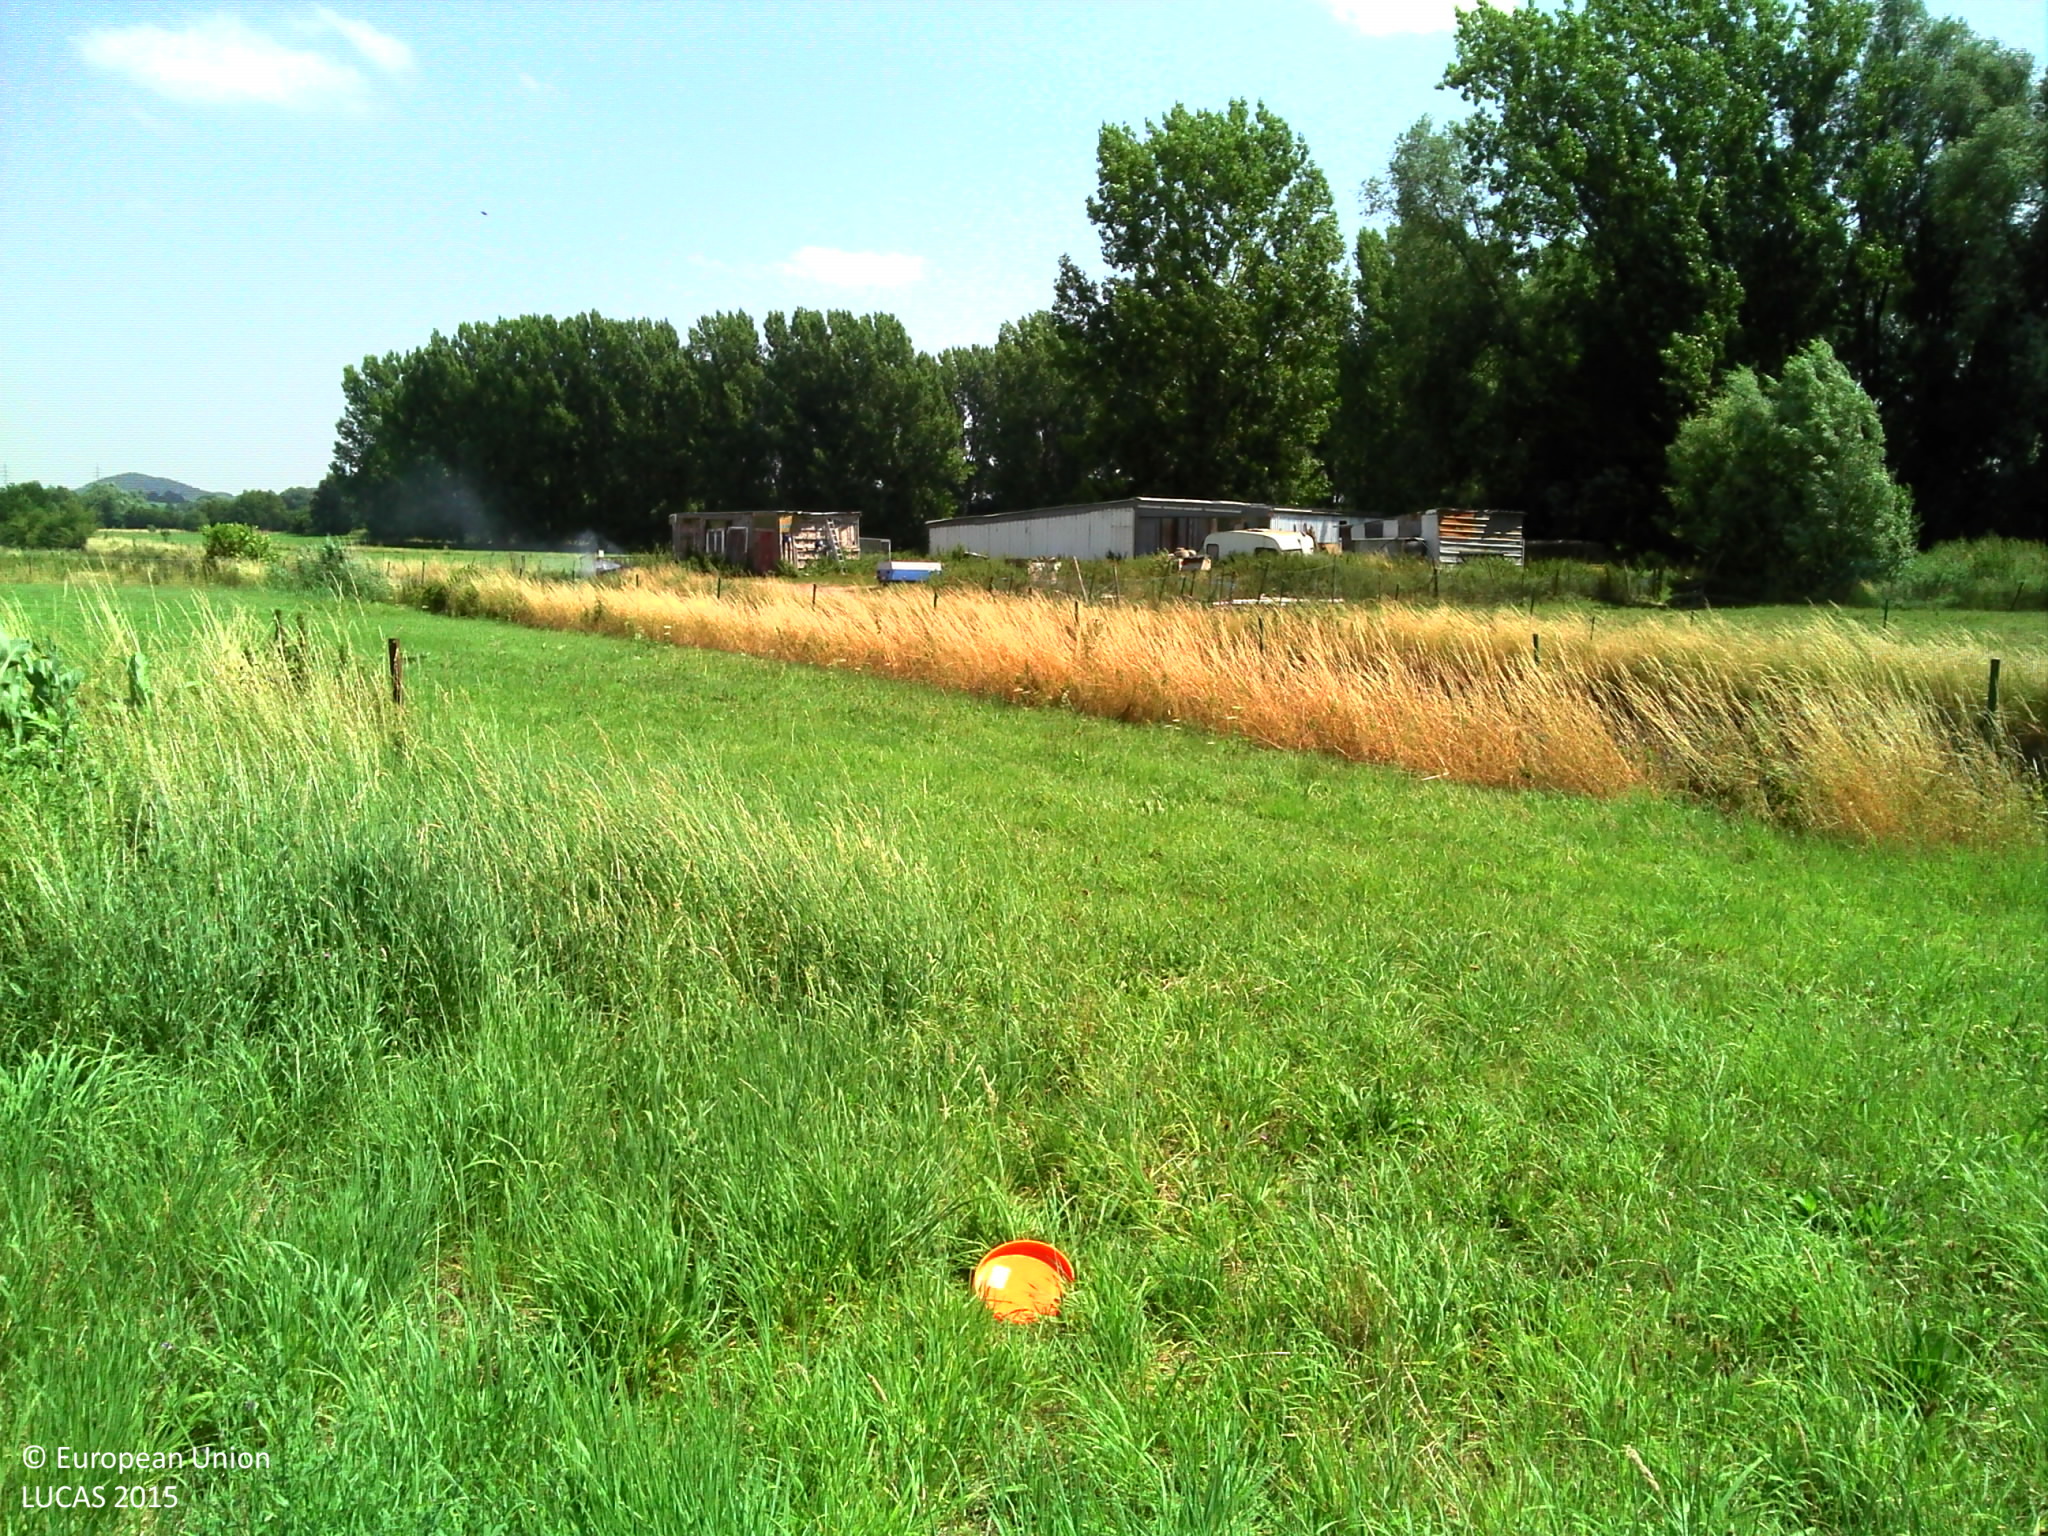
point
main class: Grassland
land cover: Grassland without tree/shrub cover
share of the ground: > 75 %
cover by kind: herbaceous plants 100 %
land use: Agriculture (excluding fallow land and kitchen gardens)
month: July
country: BE
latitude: 50.4473
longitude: 4.1222
